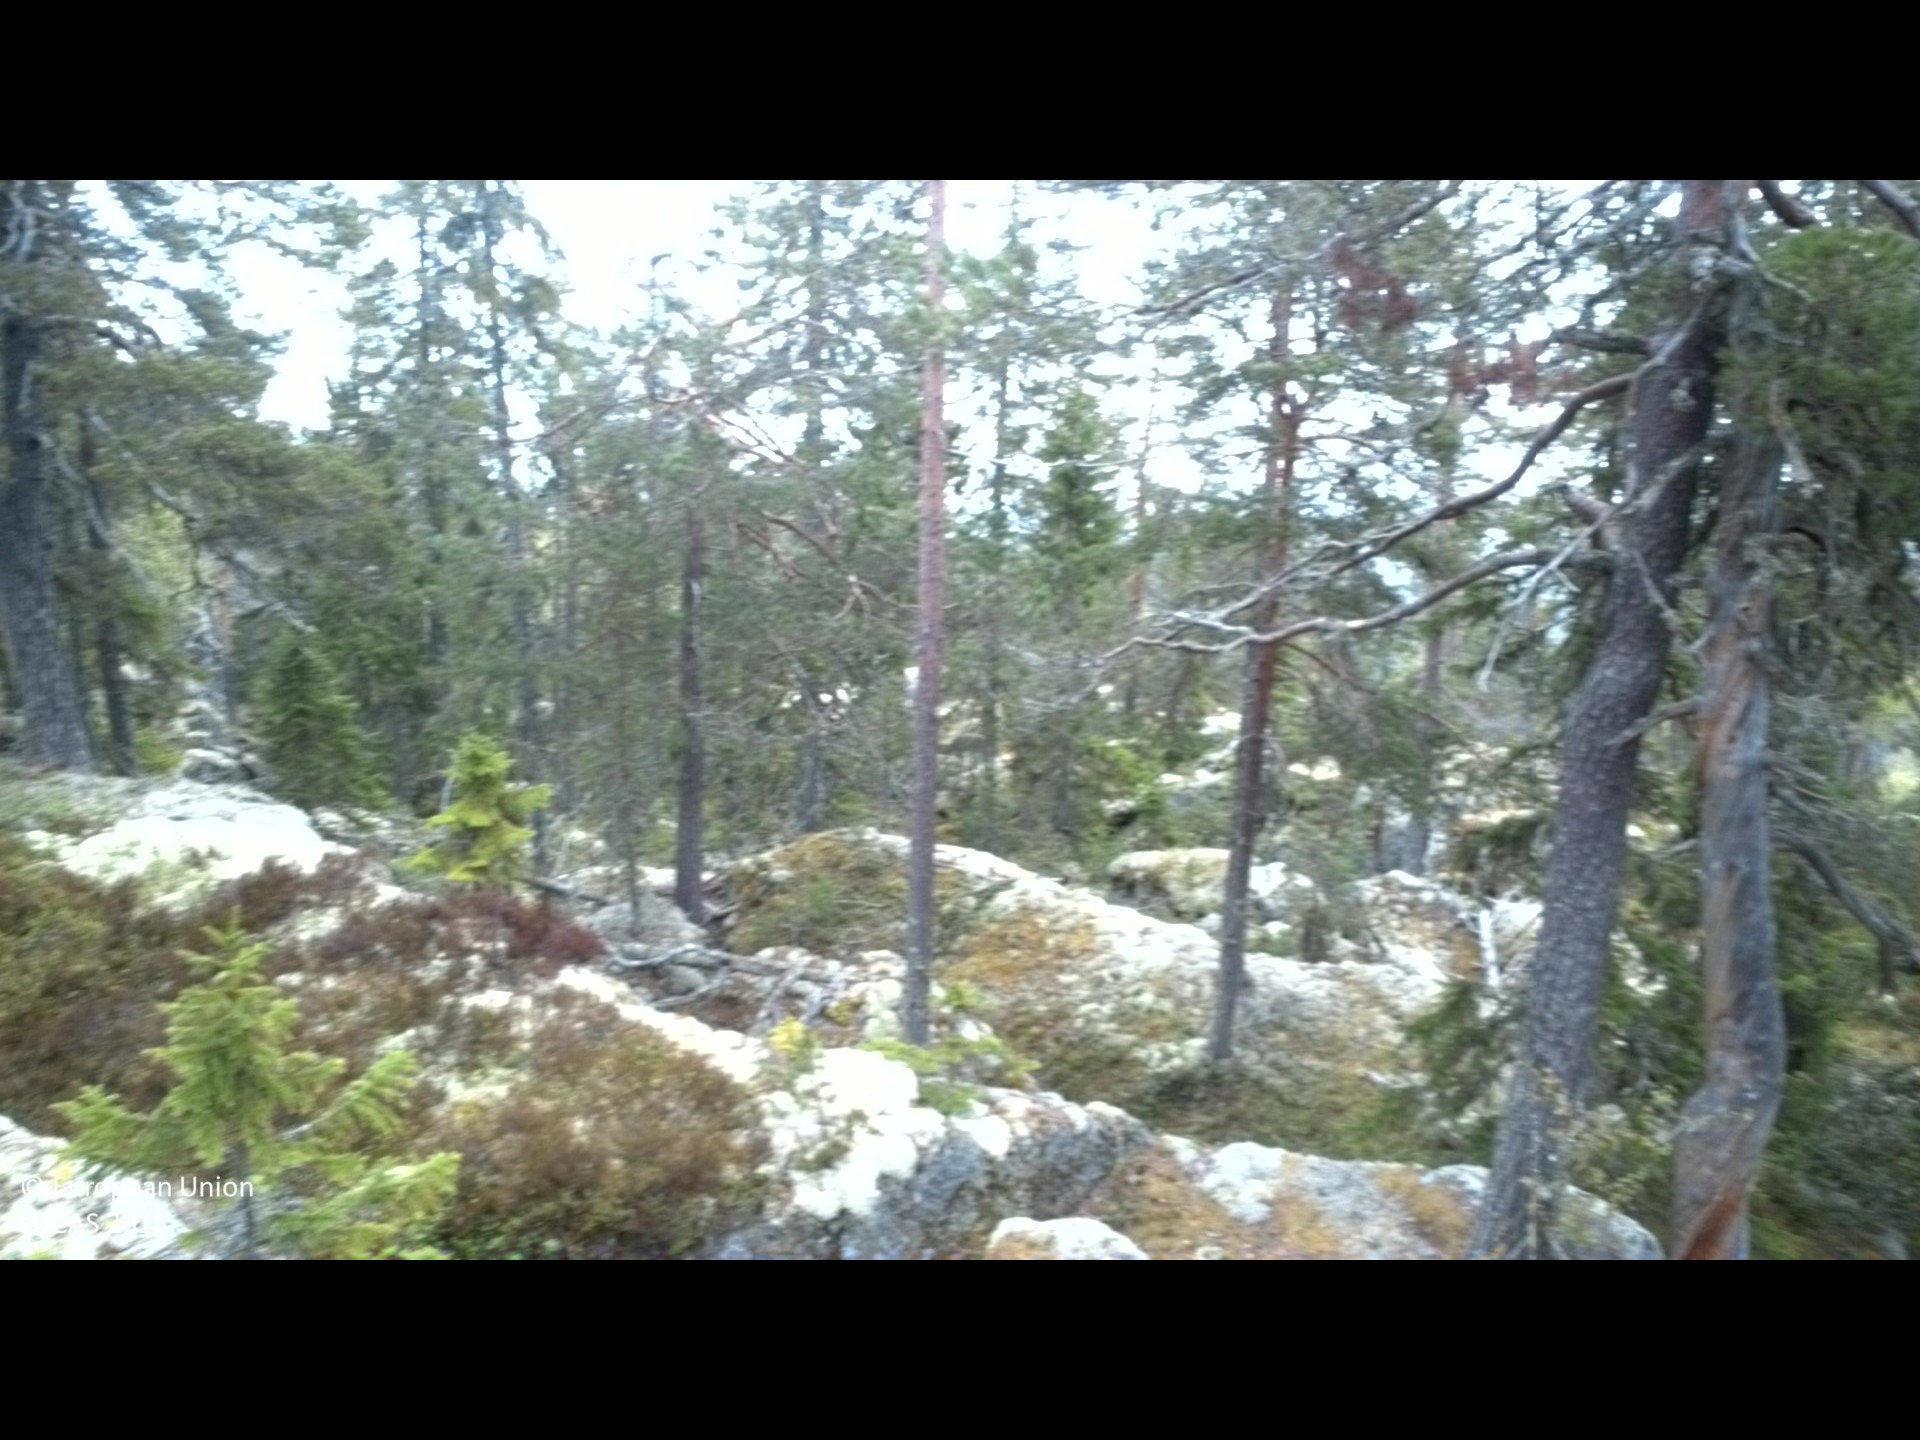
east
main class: Woodland
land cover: Spruce dominated mixed woodland
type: boreal forest
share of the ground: > 75 %
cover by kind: coniferous forest trees 60 %, broadleaved forest trees 20 %, shrubs 10 %, herbaceous plants 10 %
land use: Forestry
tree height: > 5 m
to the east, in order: Spruce dominated mixed woodland; Pine dominated mixed woodland
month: May
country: SE
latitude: 62.9220
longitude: 17.7166
